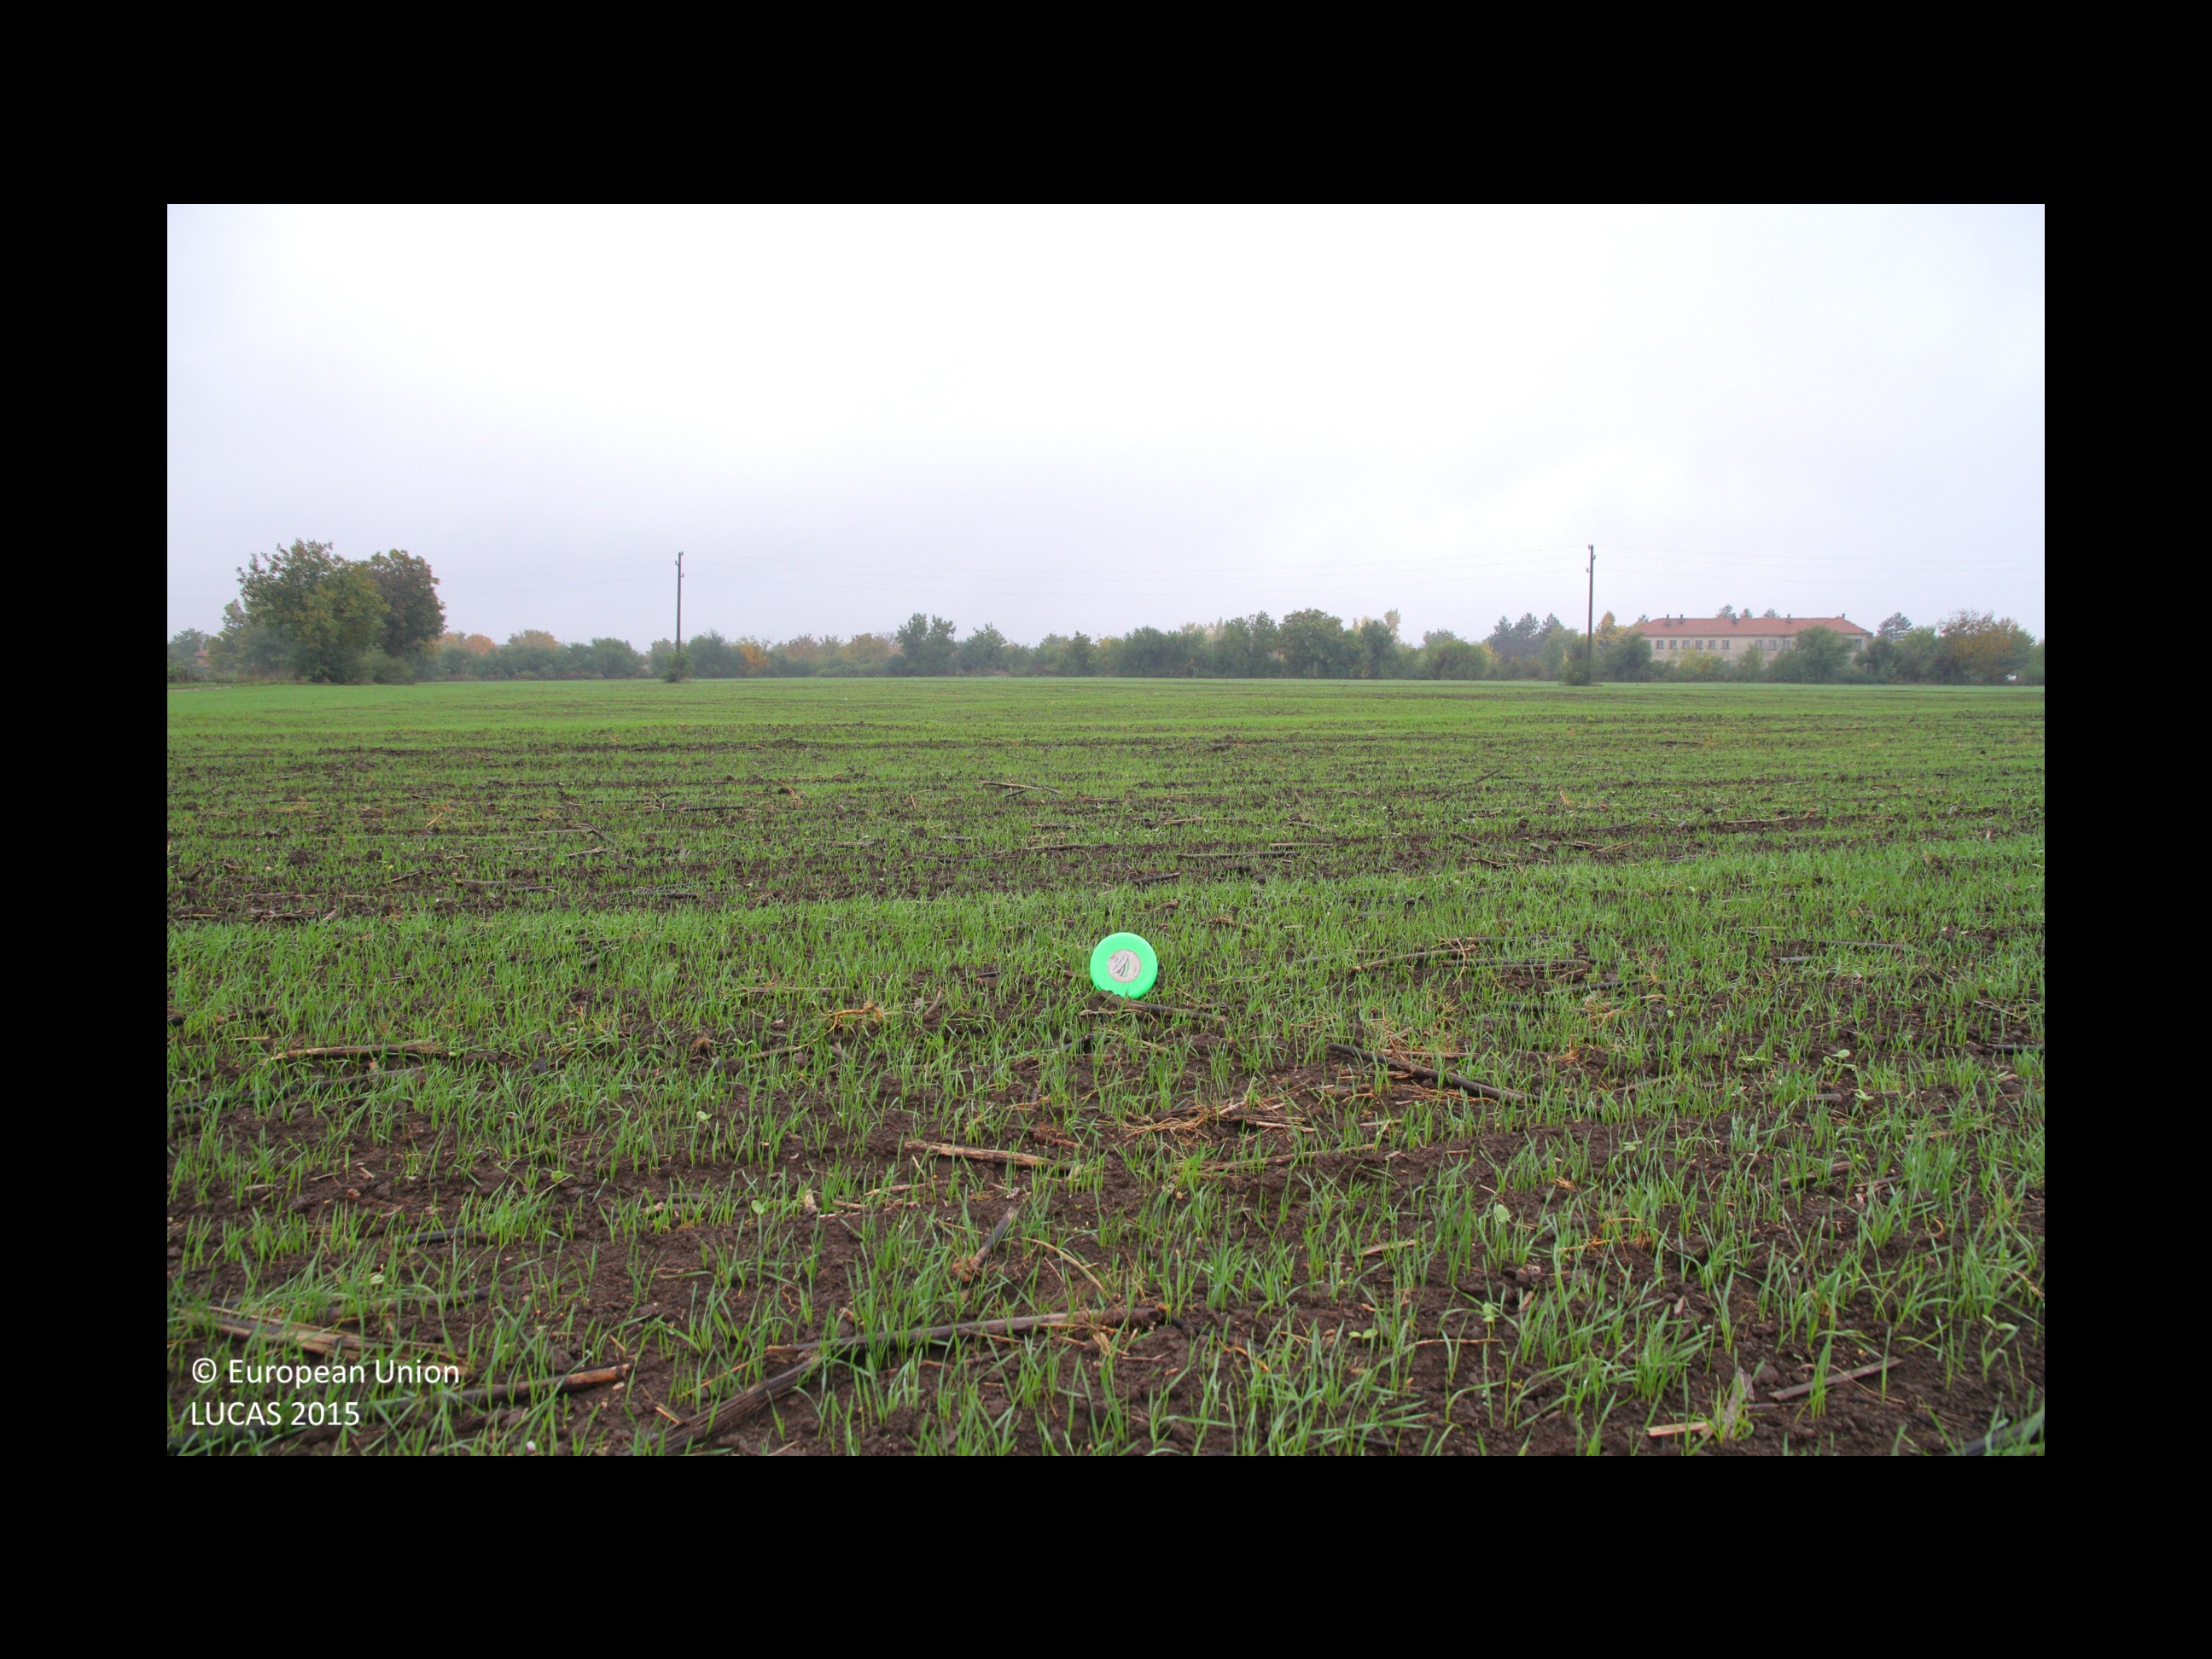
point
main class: Cropland
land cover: Common wheat
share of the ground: 25 - 50 %
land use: Agriculture (excluding fallow land and kitchen gardens)
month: October
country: BG
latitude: 43.6714
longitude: 26.9994
